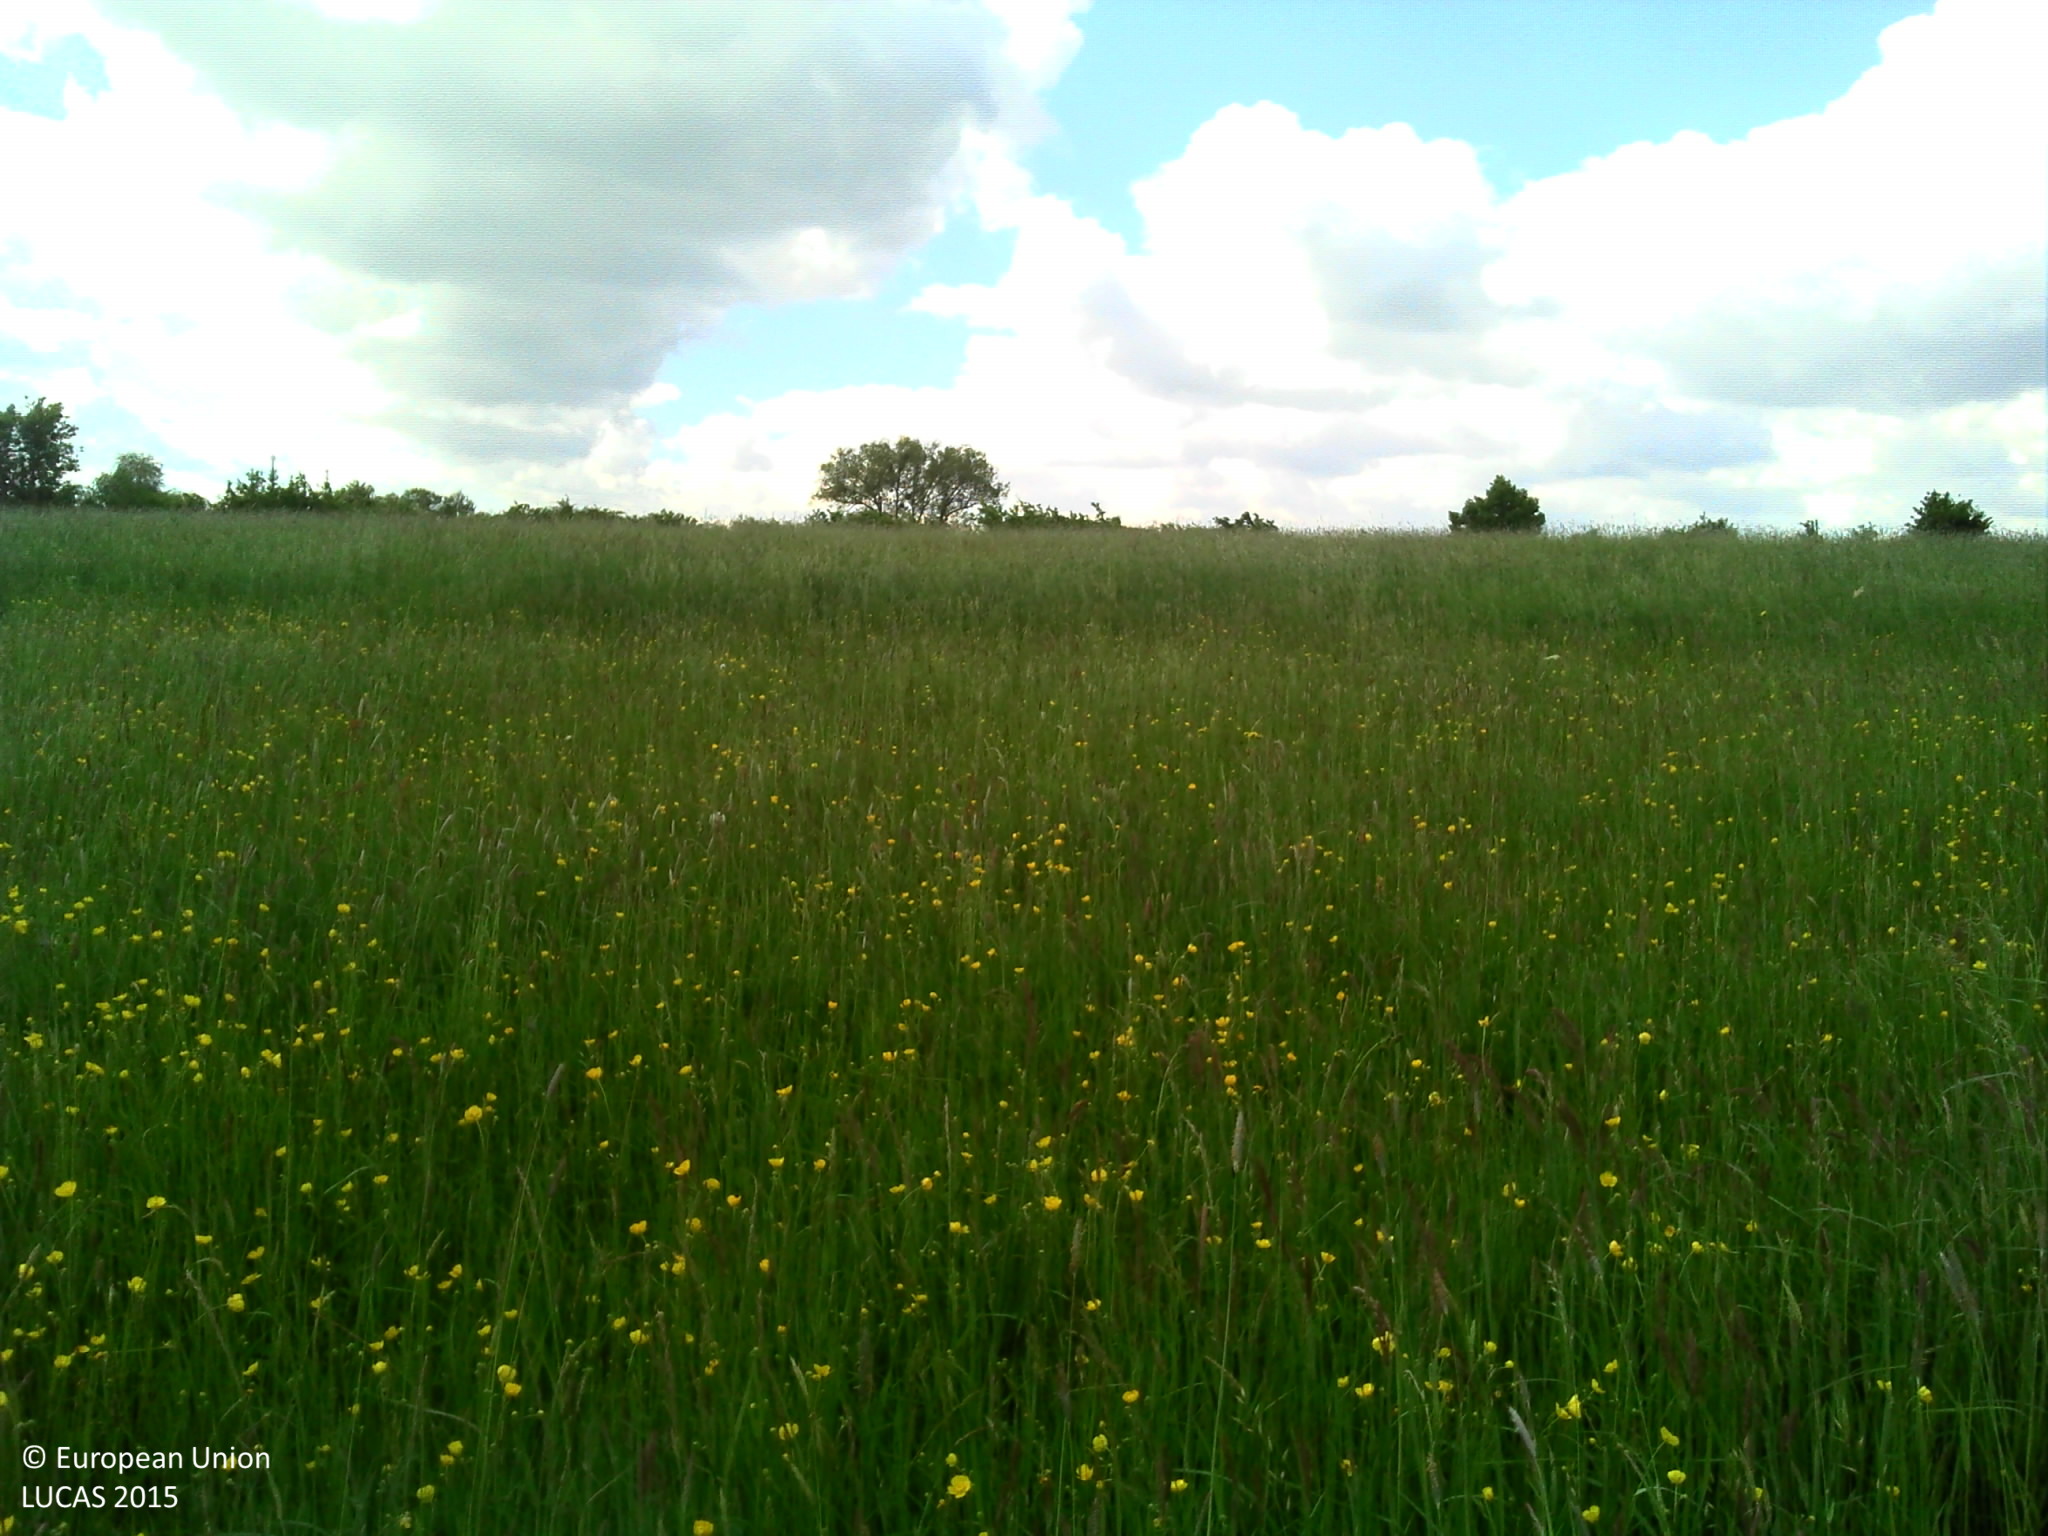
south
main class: Grassland
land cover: Grassland without tree/shrub cover
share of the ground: > 75 %
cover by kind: herbaceous plants 100 %
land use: Agriculture (excluding fallow land and kitchen gardens)
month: May
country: LU
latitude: 49.6109
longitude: 6.0274
